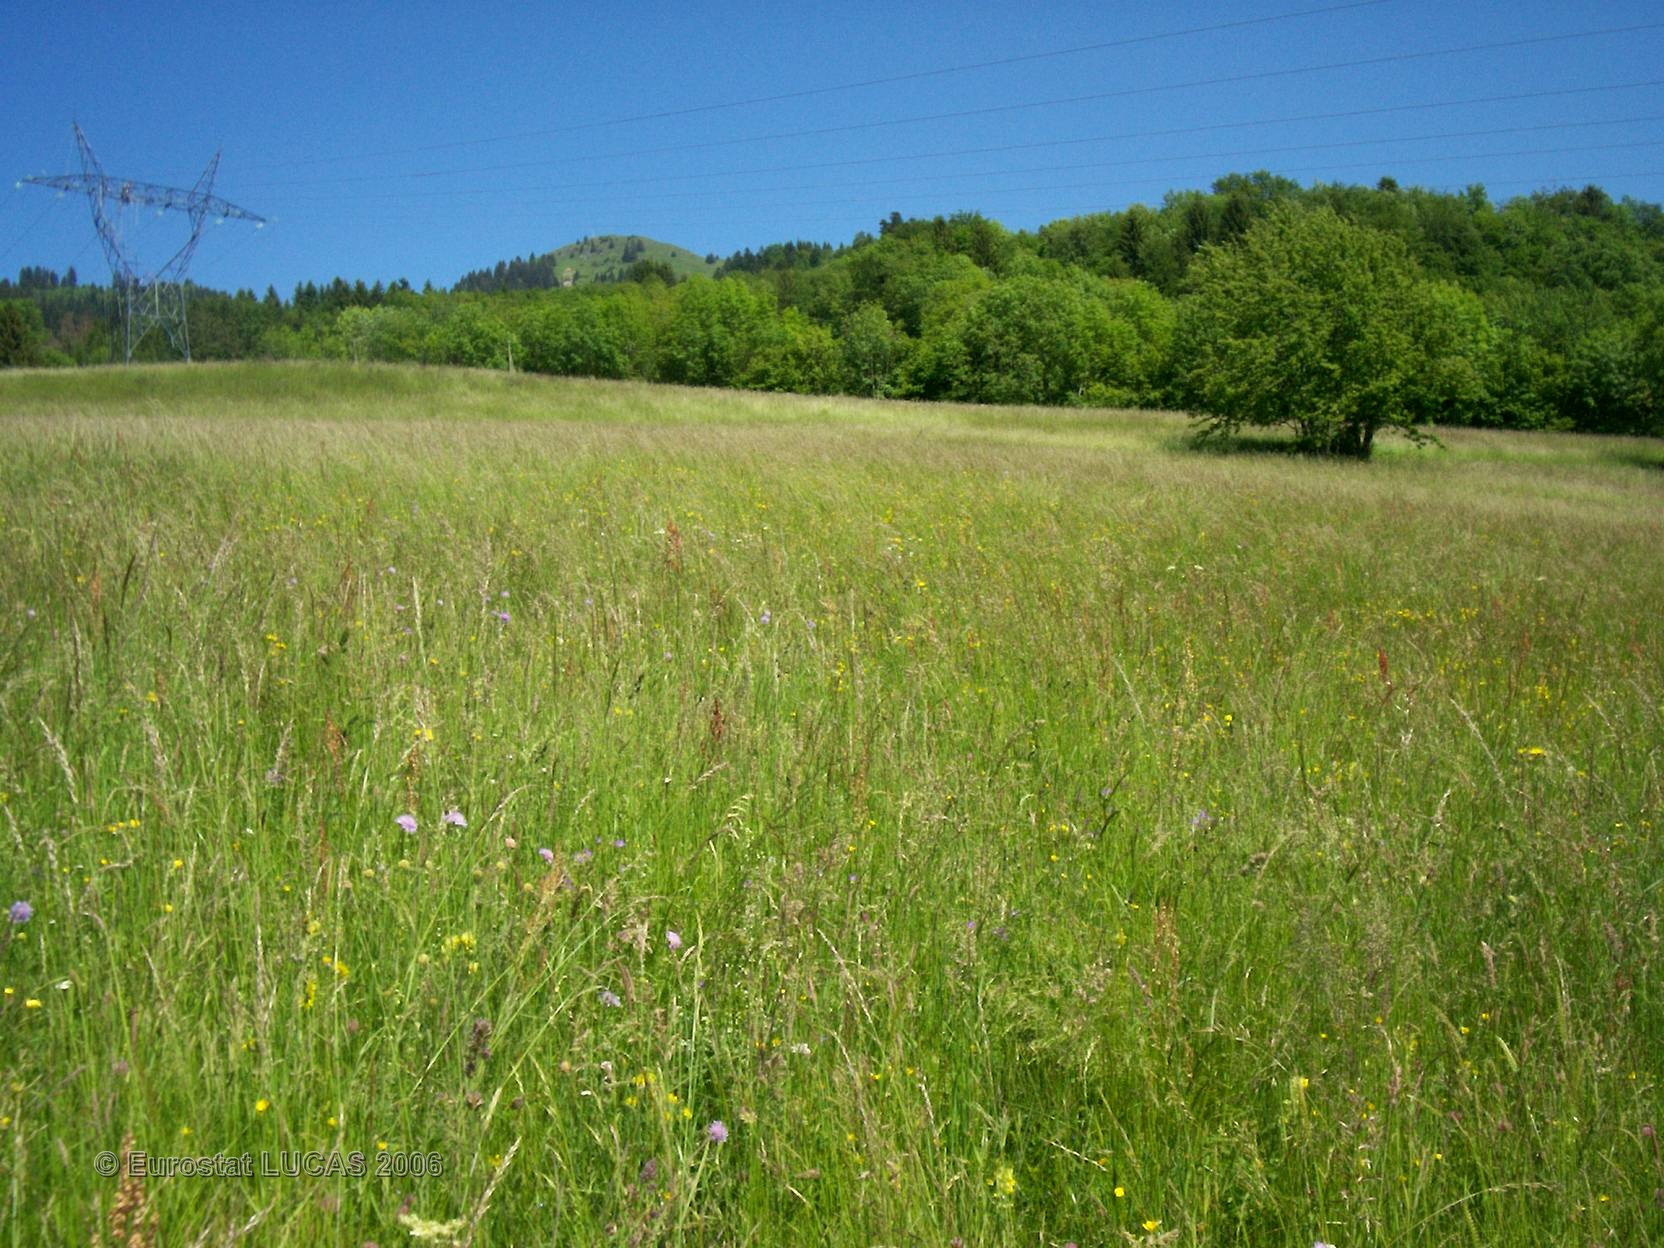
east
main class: Grassland
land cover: Grassland with sparse tree/shrub cover
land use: Agriculture (excluding fallow land and kitchen gardens)
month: June
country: FR
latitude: 46.1650
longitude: 6.4161
